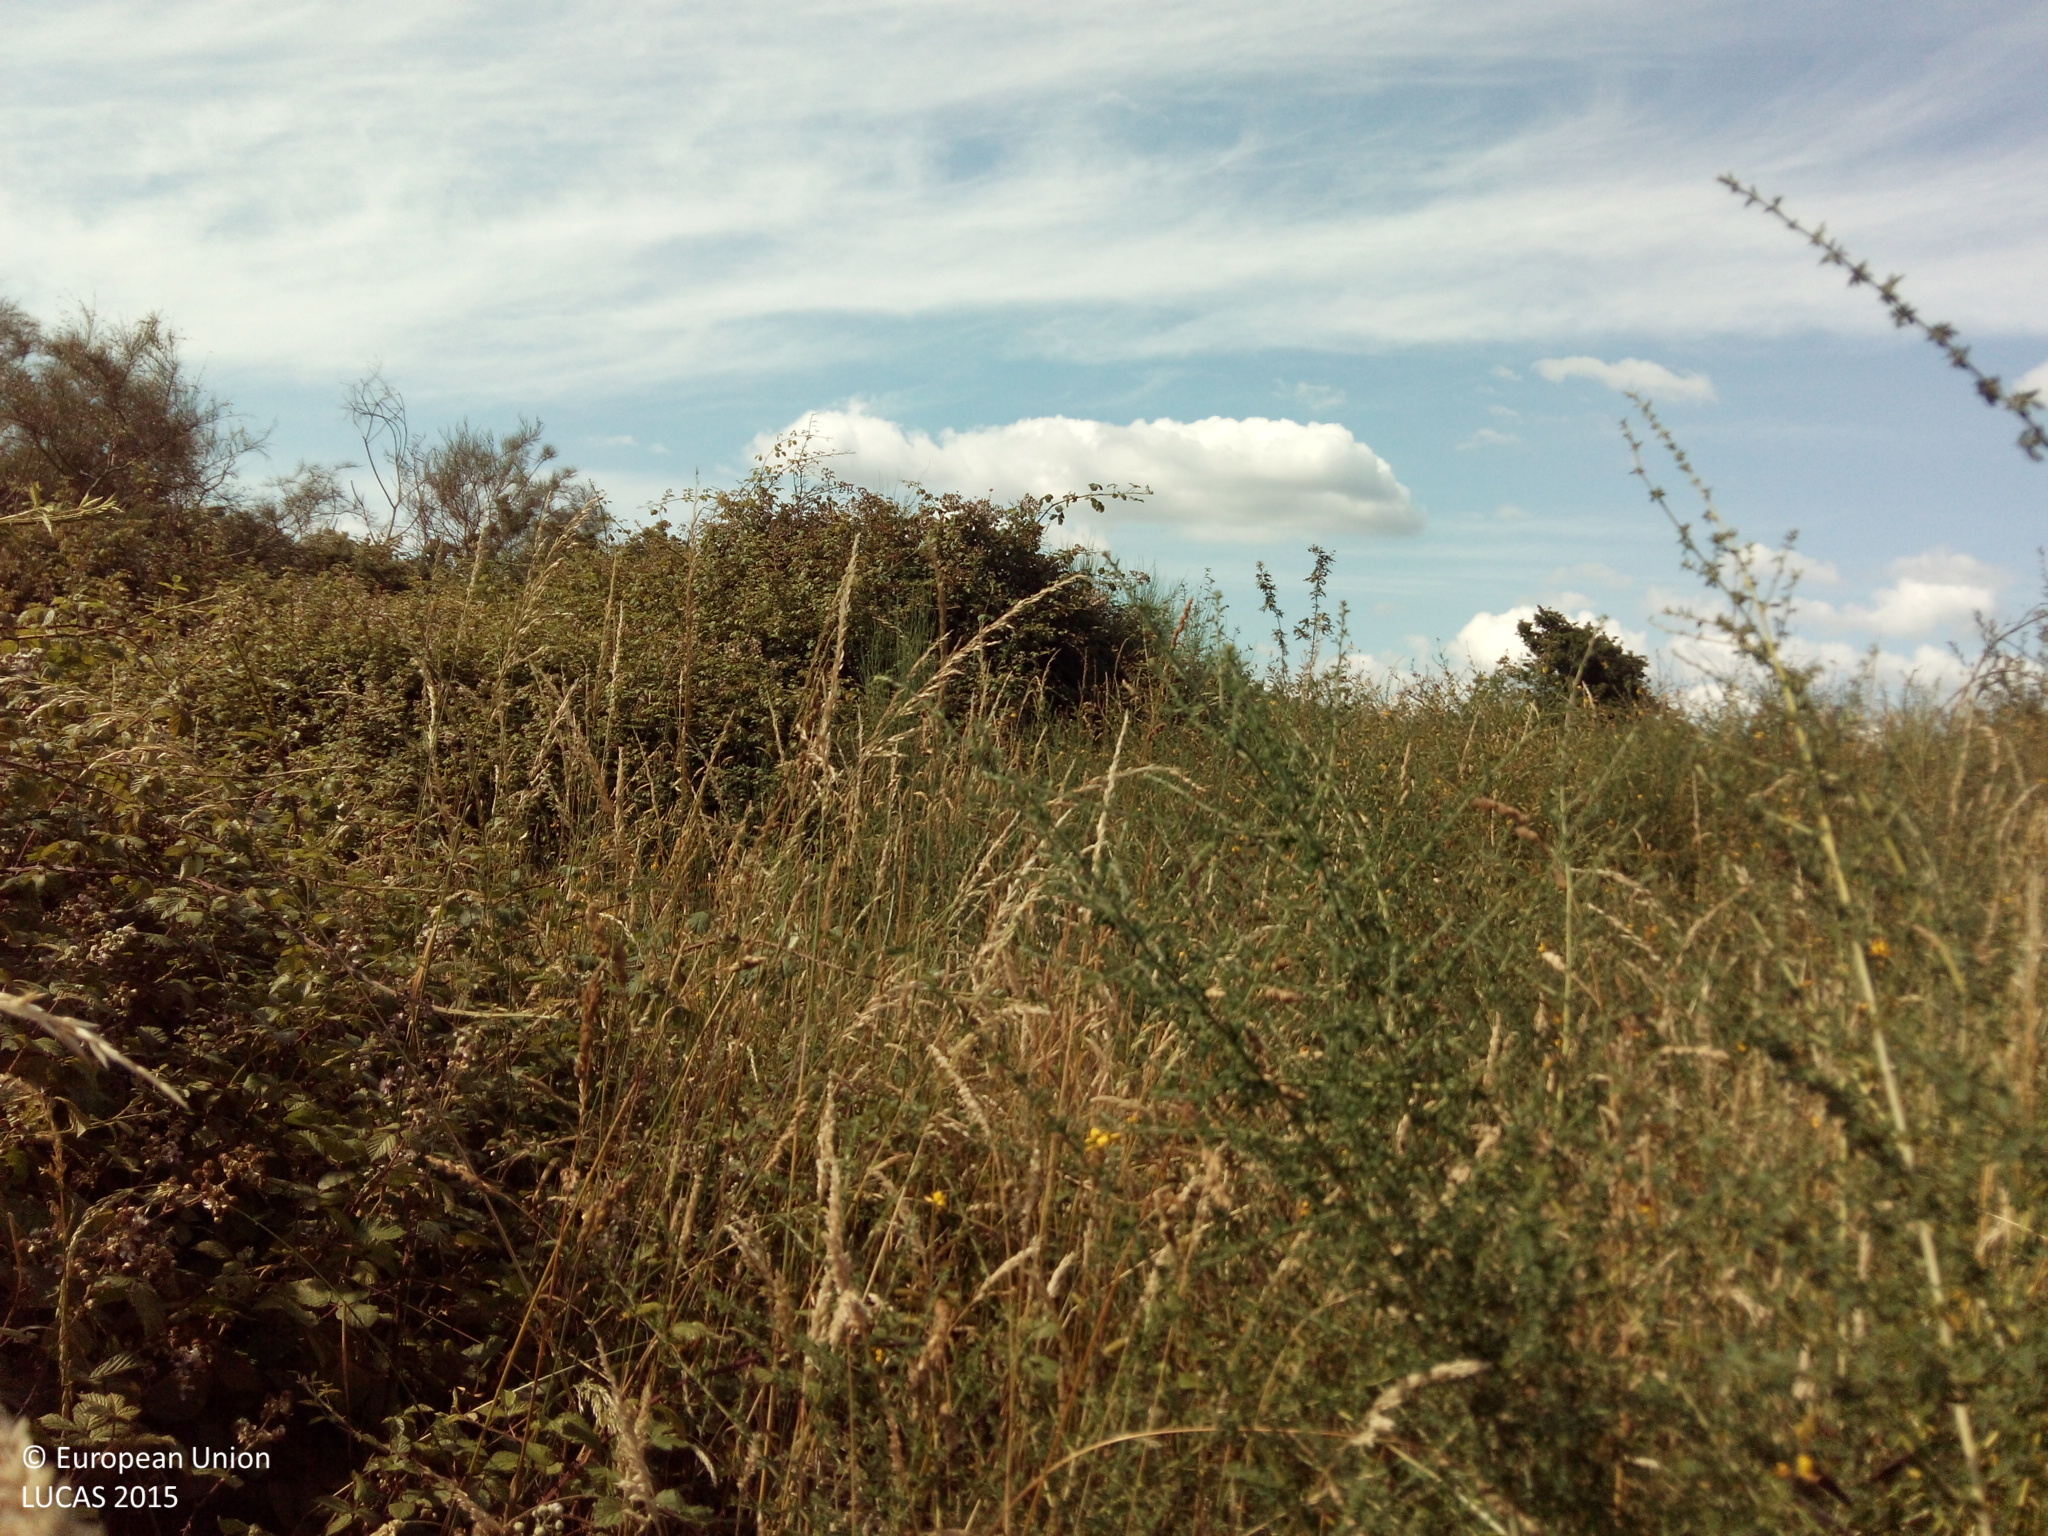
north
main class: Shrubland
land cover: Shrubland without tree cover
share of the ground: > 75 %
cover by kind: shrubs 100 %
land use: Abandoned areas
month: July
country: ES
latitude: 42.8367
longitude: -7.9862
